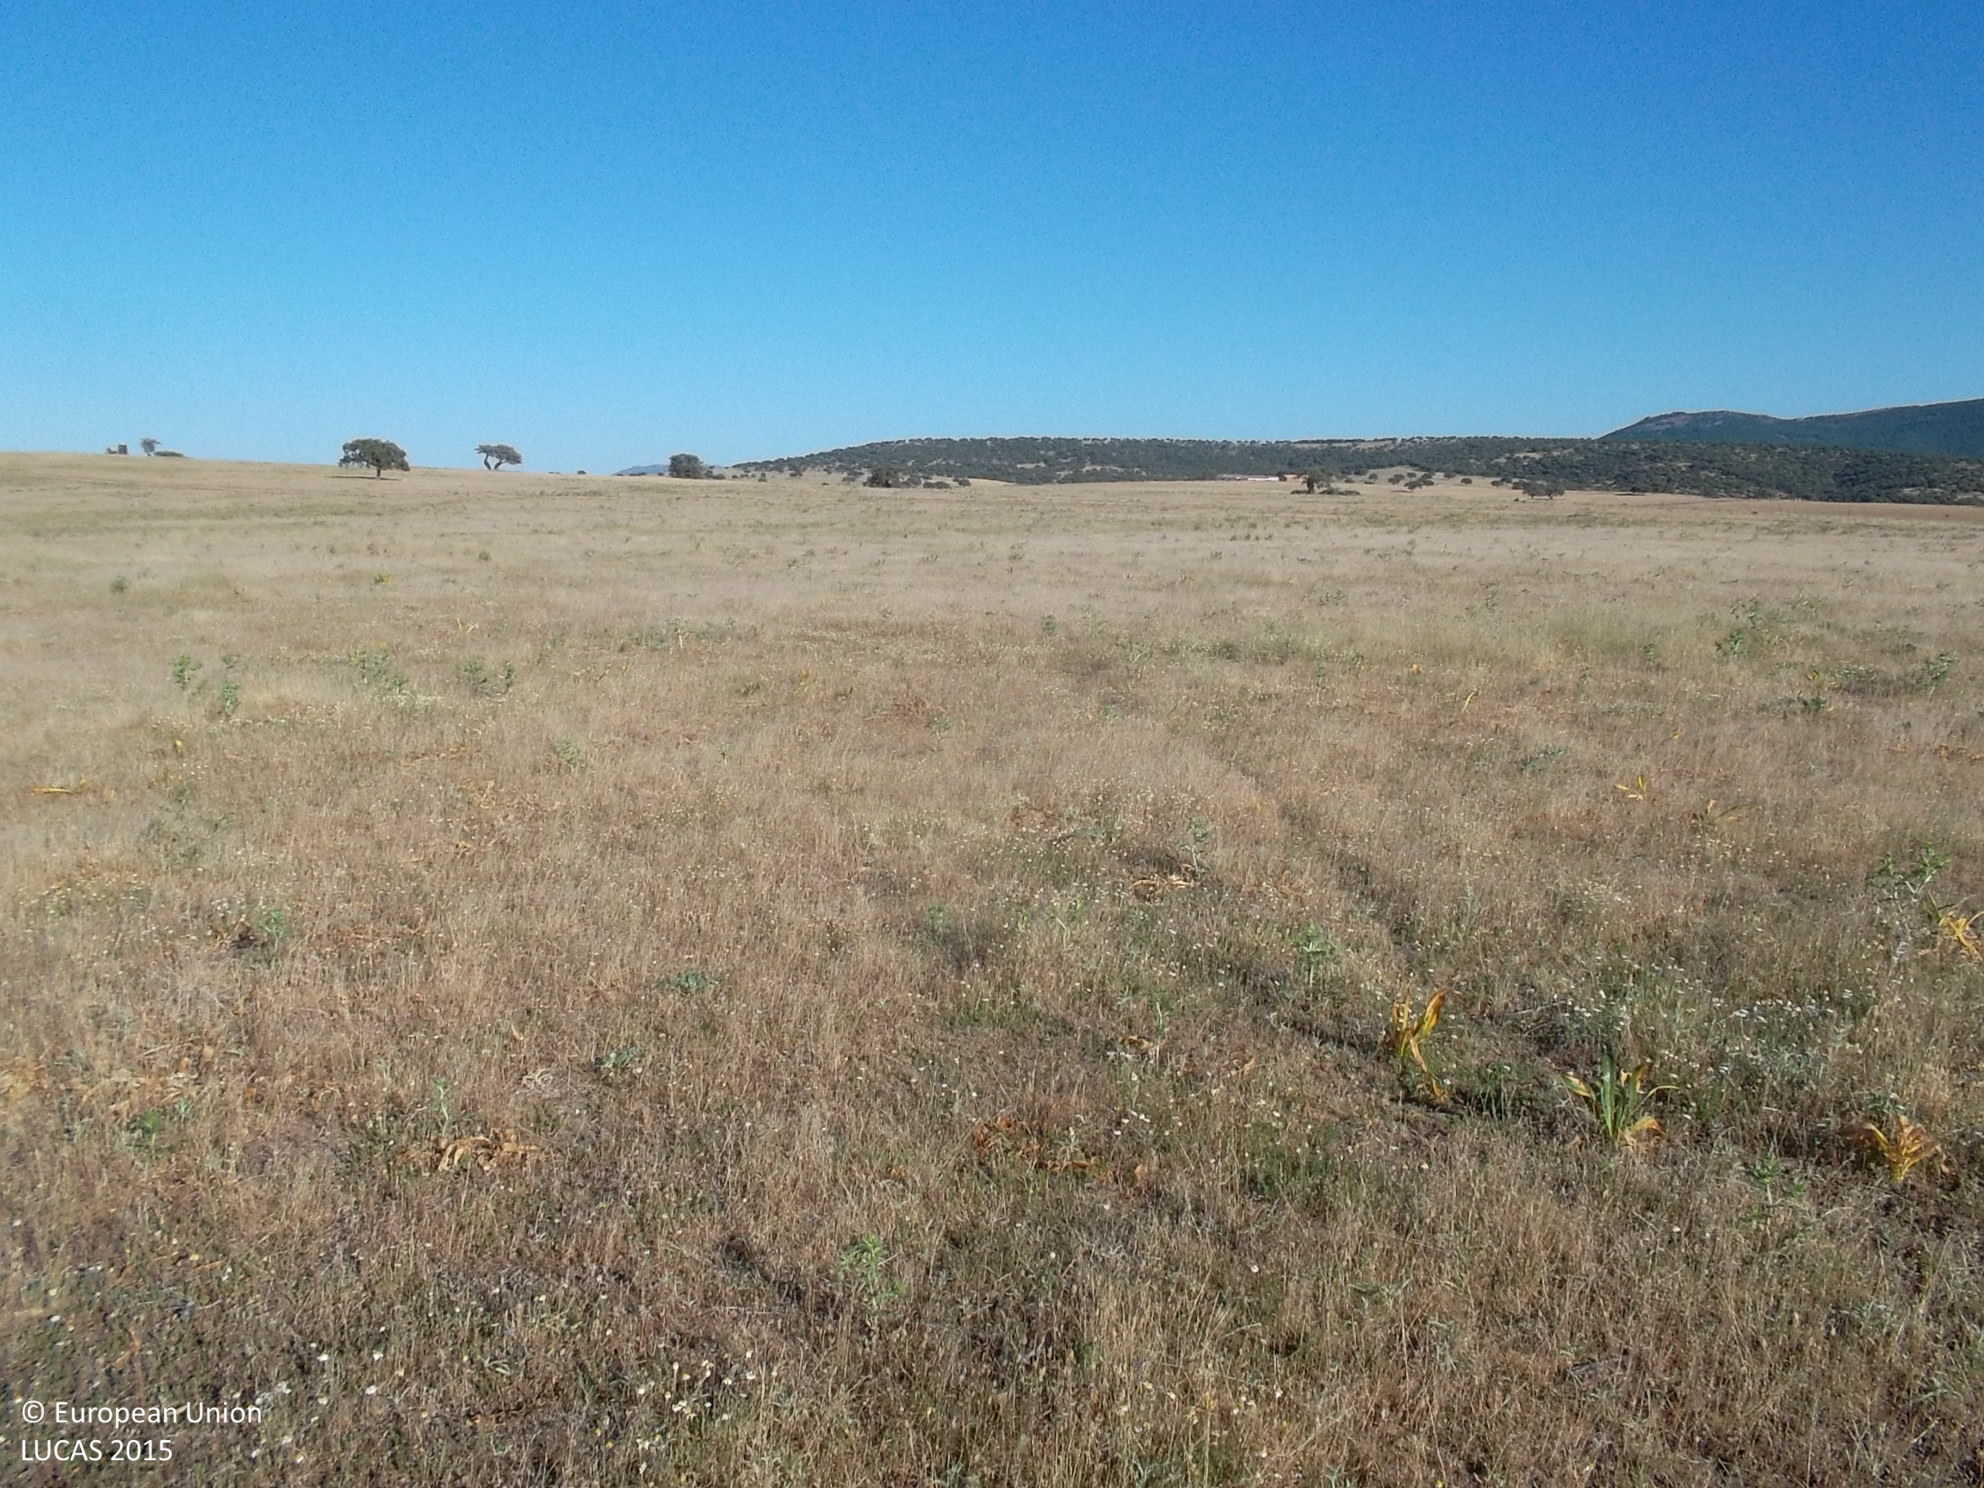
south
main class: Grassland
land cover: Grassland without tree/shrub cover
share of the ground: > 75 %
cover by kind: herbaceous plants 95 %, shrubs 5 %
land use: Agriculture (excluding fallow land and kitchen gardens)
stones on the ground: < 10 %
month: May
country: ES
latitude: 38.6174
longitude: -4.4818
